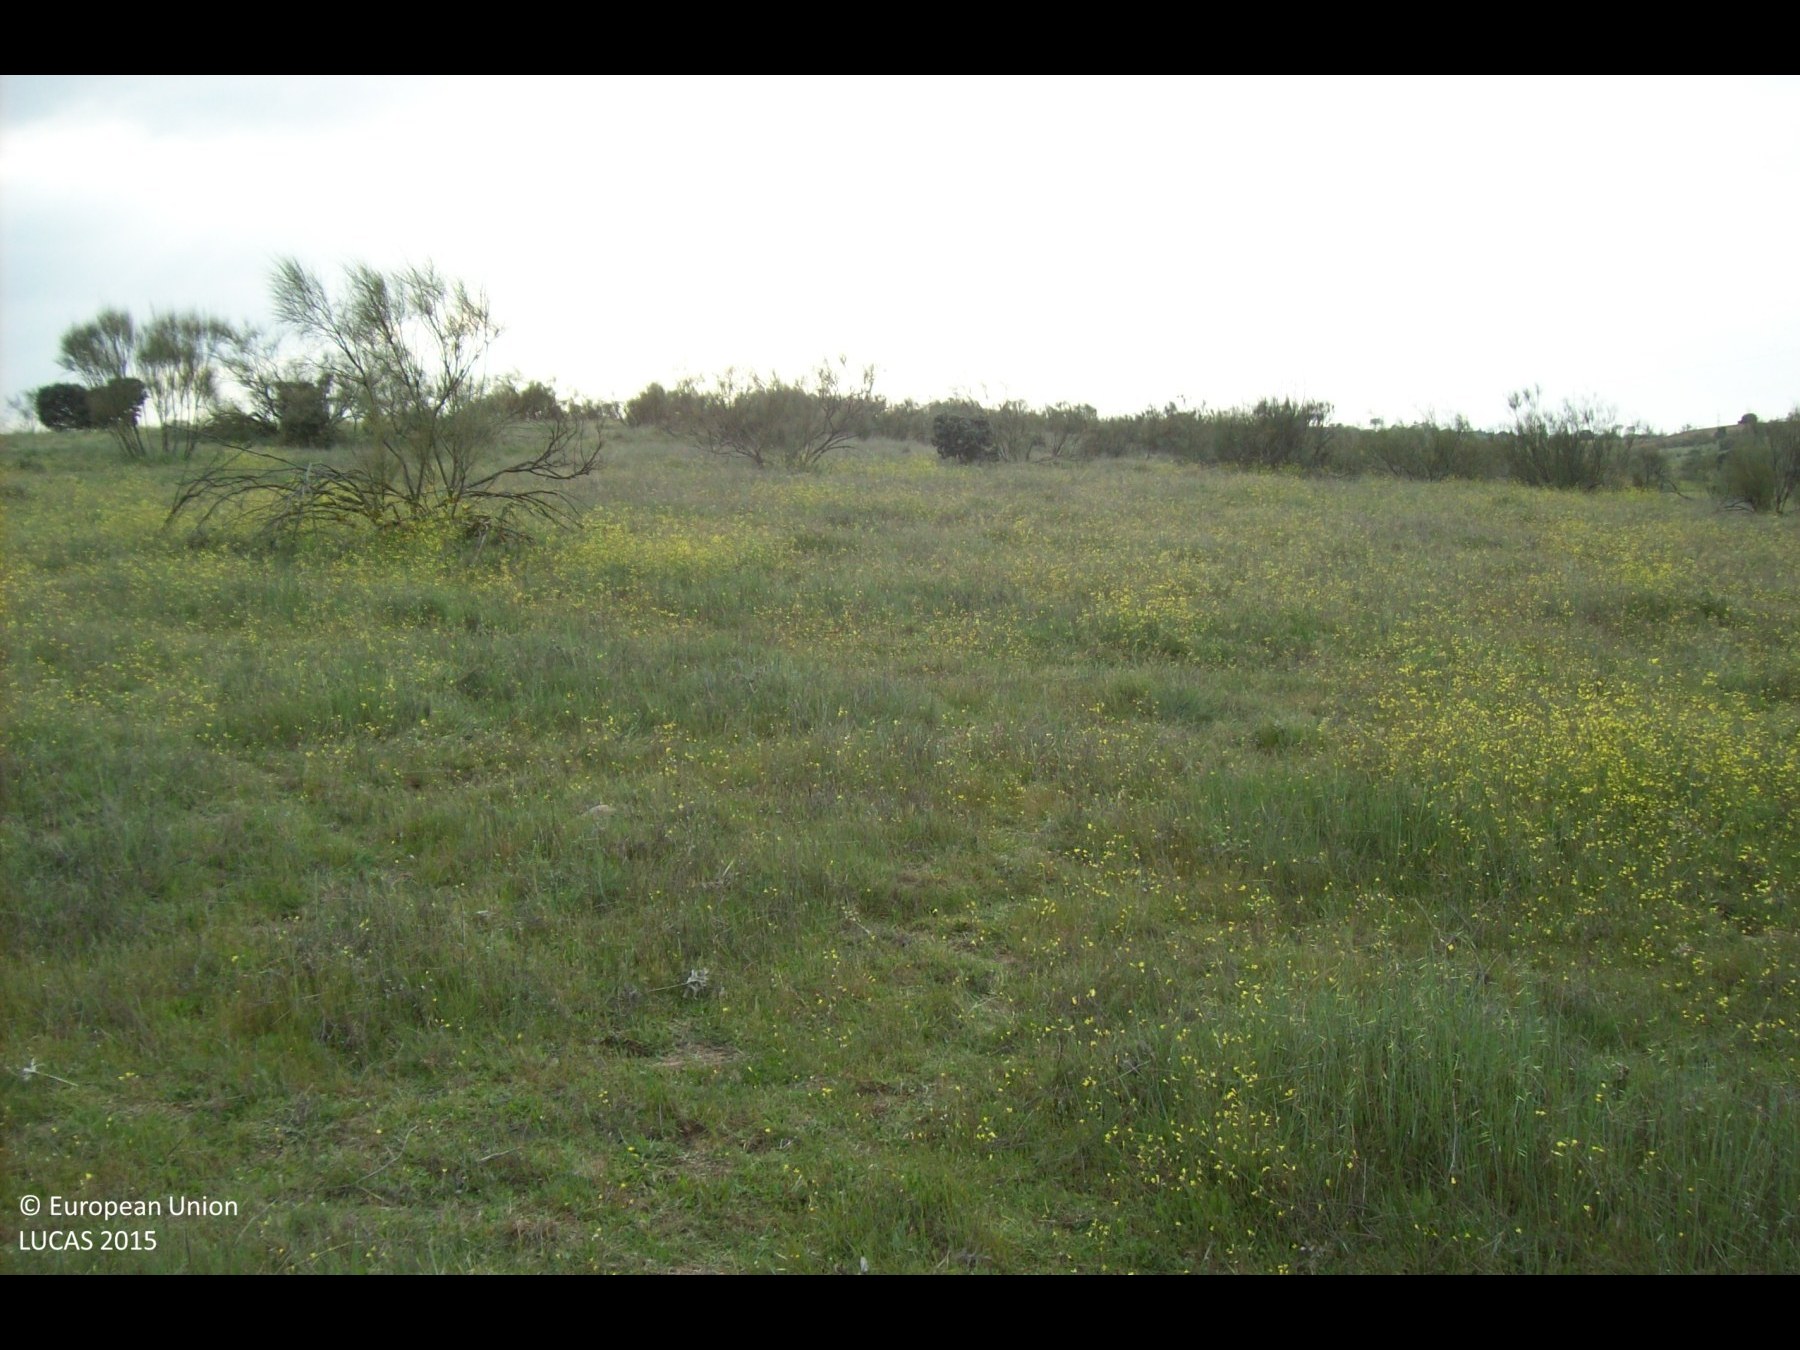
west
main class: Grassland
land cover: Grassland with sparse tree/shrub cover
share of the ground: > 75 %
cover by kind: herbaceous plants 90 %, broadleaved forest trees 5 %, shrubs 5 %
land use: Semi-natural and natural areas not in use
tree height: < 5 m
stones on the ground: < 10 %
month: April
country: ES
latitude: 40.5060
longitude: -3.8596
